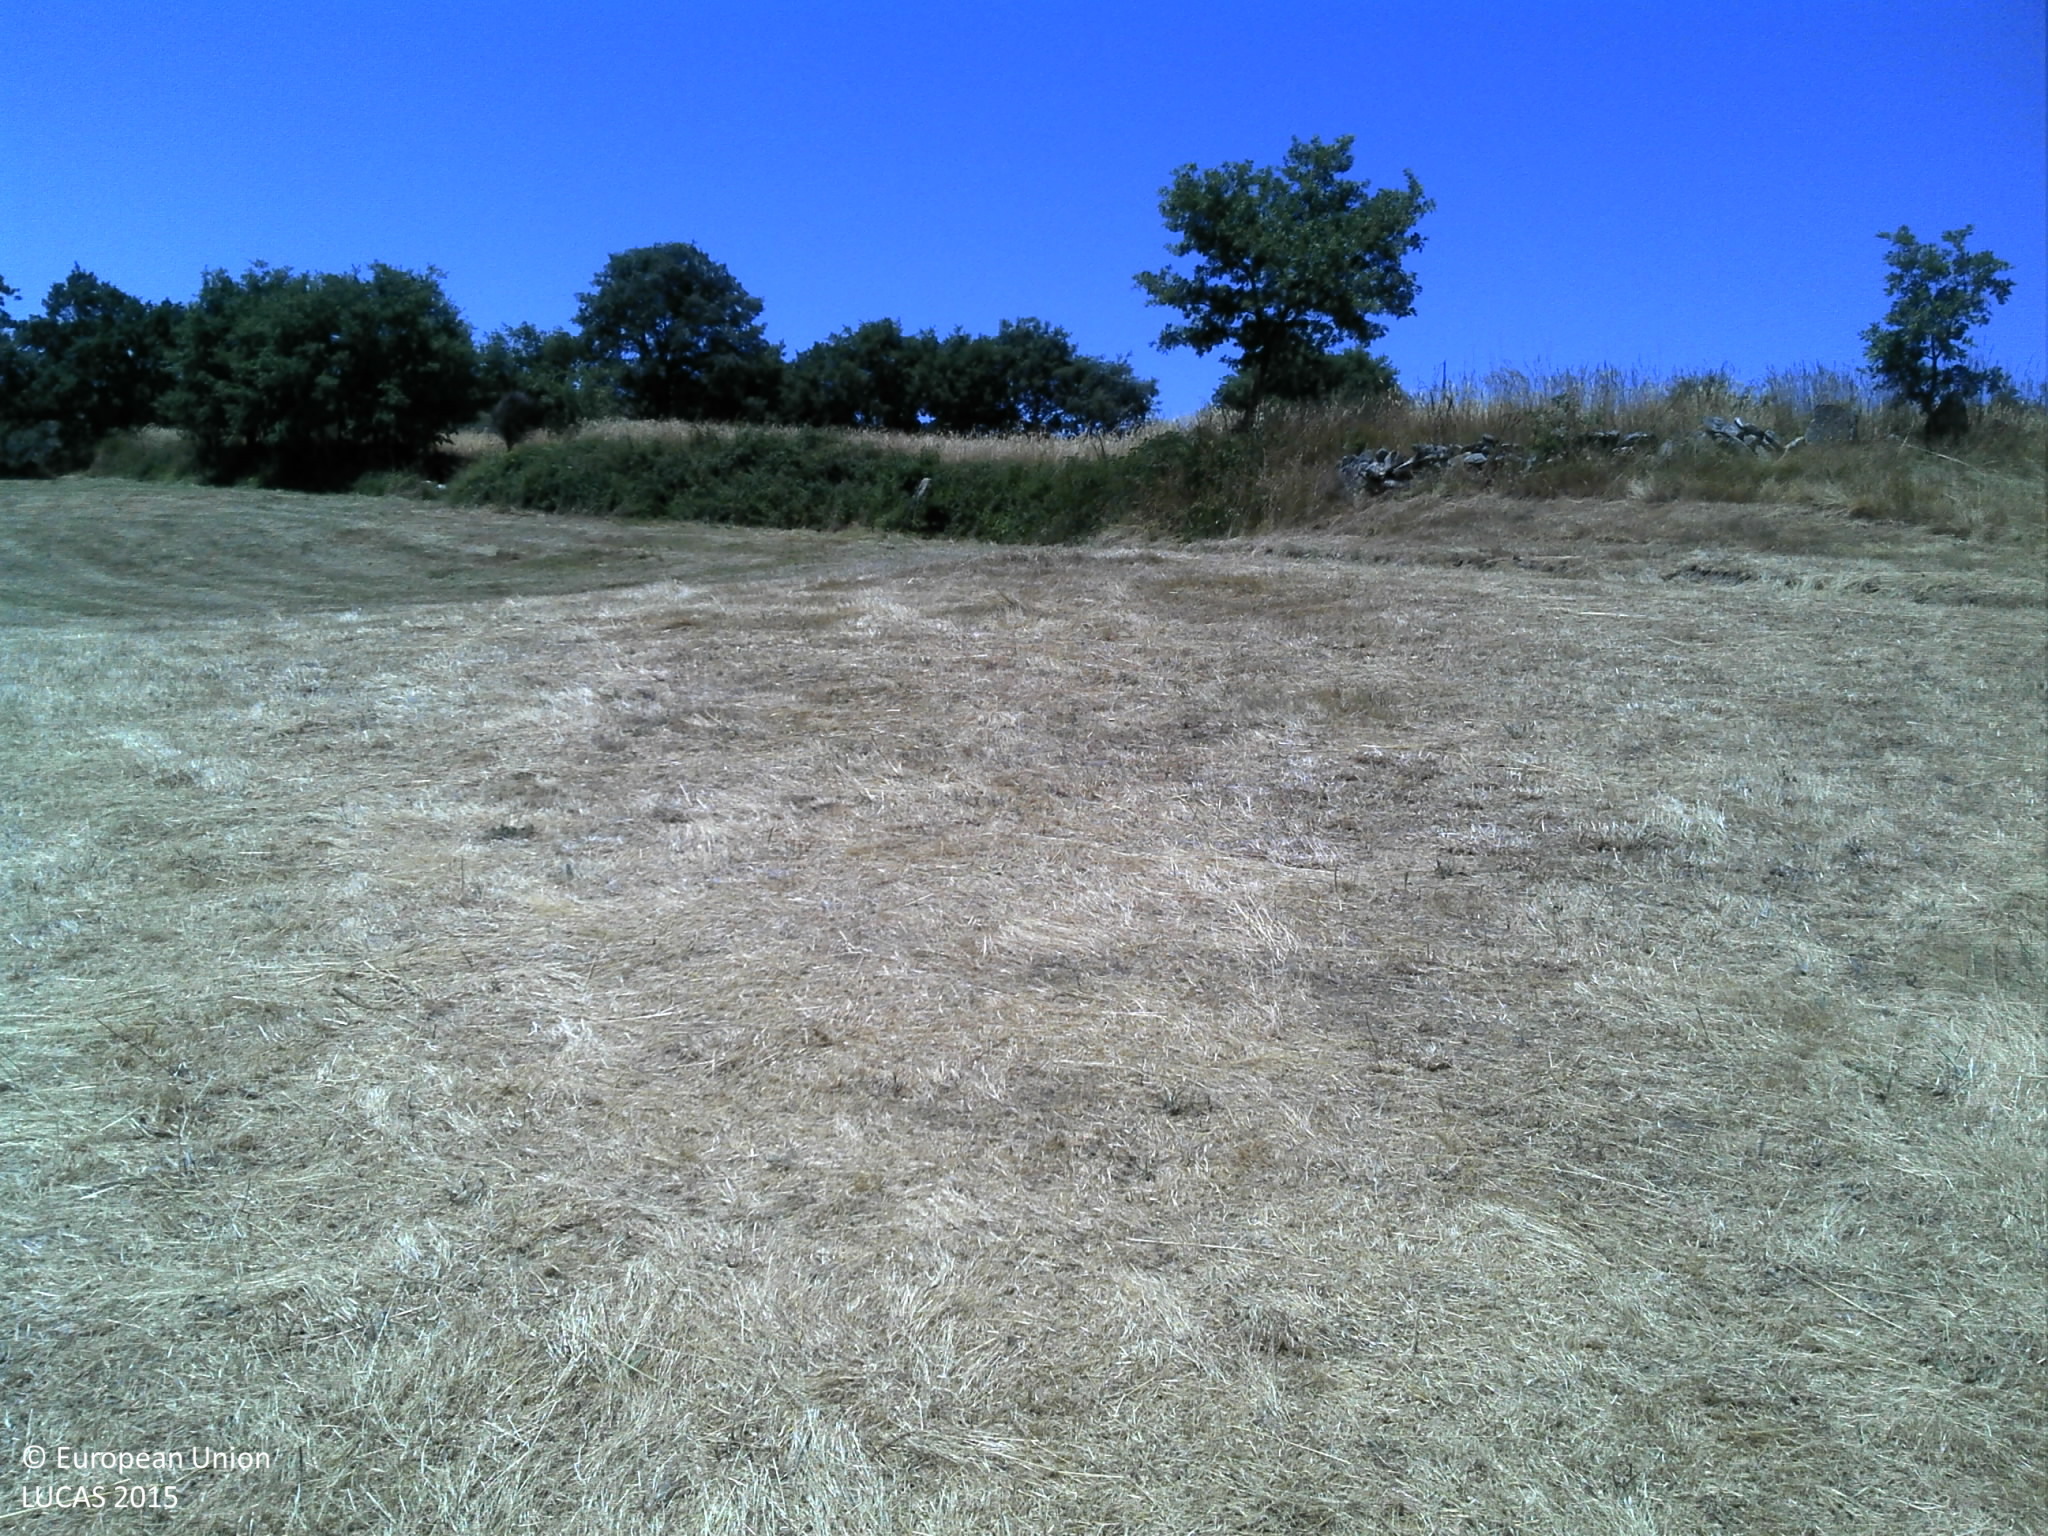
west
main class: Grassland
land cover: Grassland without tree/shrub cover
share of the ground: > 75 %
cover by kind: herbaceous plants 90 %, unconsolidated bare surface 10 %
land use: Agriculture (excluding fallow land and kitchen gardens)
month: July
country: PT
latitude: 41.7696
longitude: -7.6627
